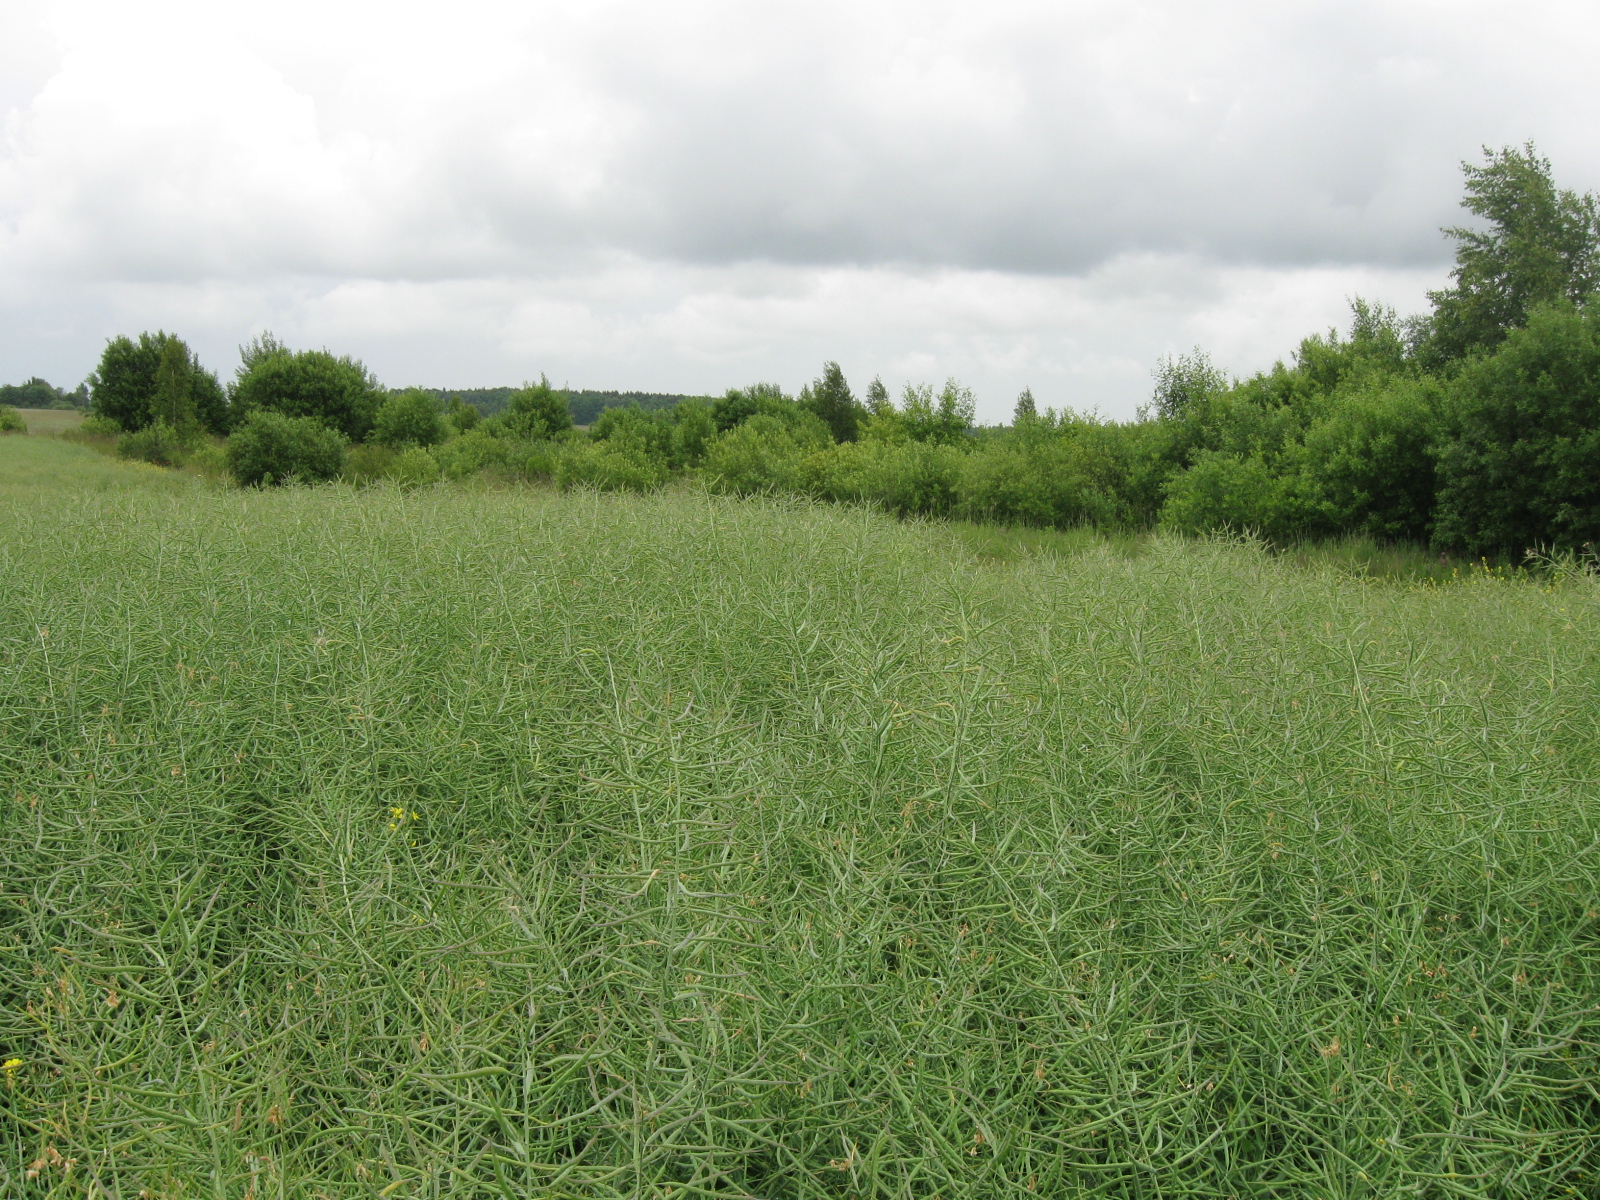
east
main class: Cropland
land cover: Rape and turnip rape
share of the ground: > 75 %
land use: Agriculture (excluding fallow land and kitchen gardens)
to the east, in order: Rape and turnip rape; Grass margins; Tracks; Grassland without tree/shrub cover
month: June
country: LT
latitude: 54.8937
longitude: 24.5569
